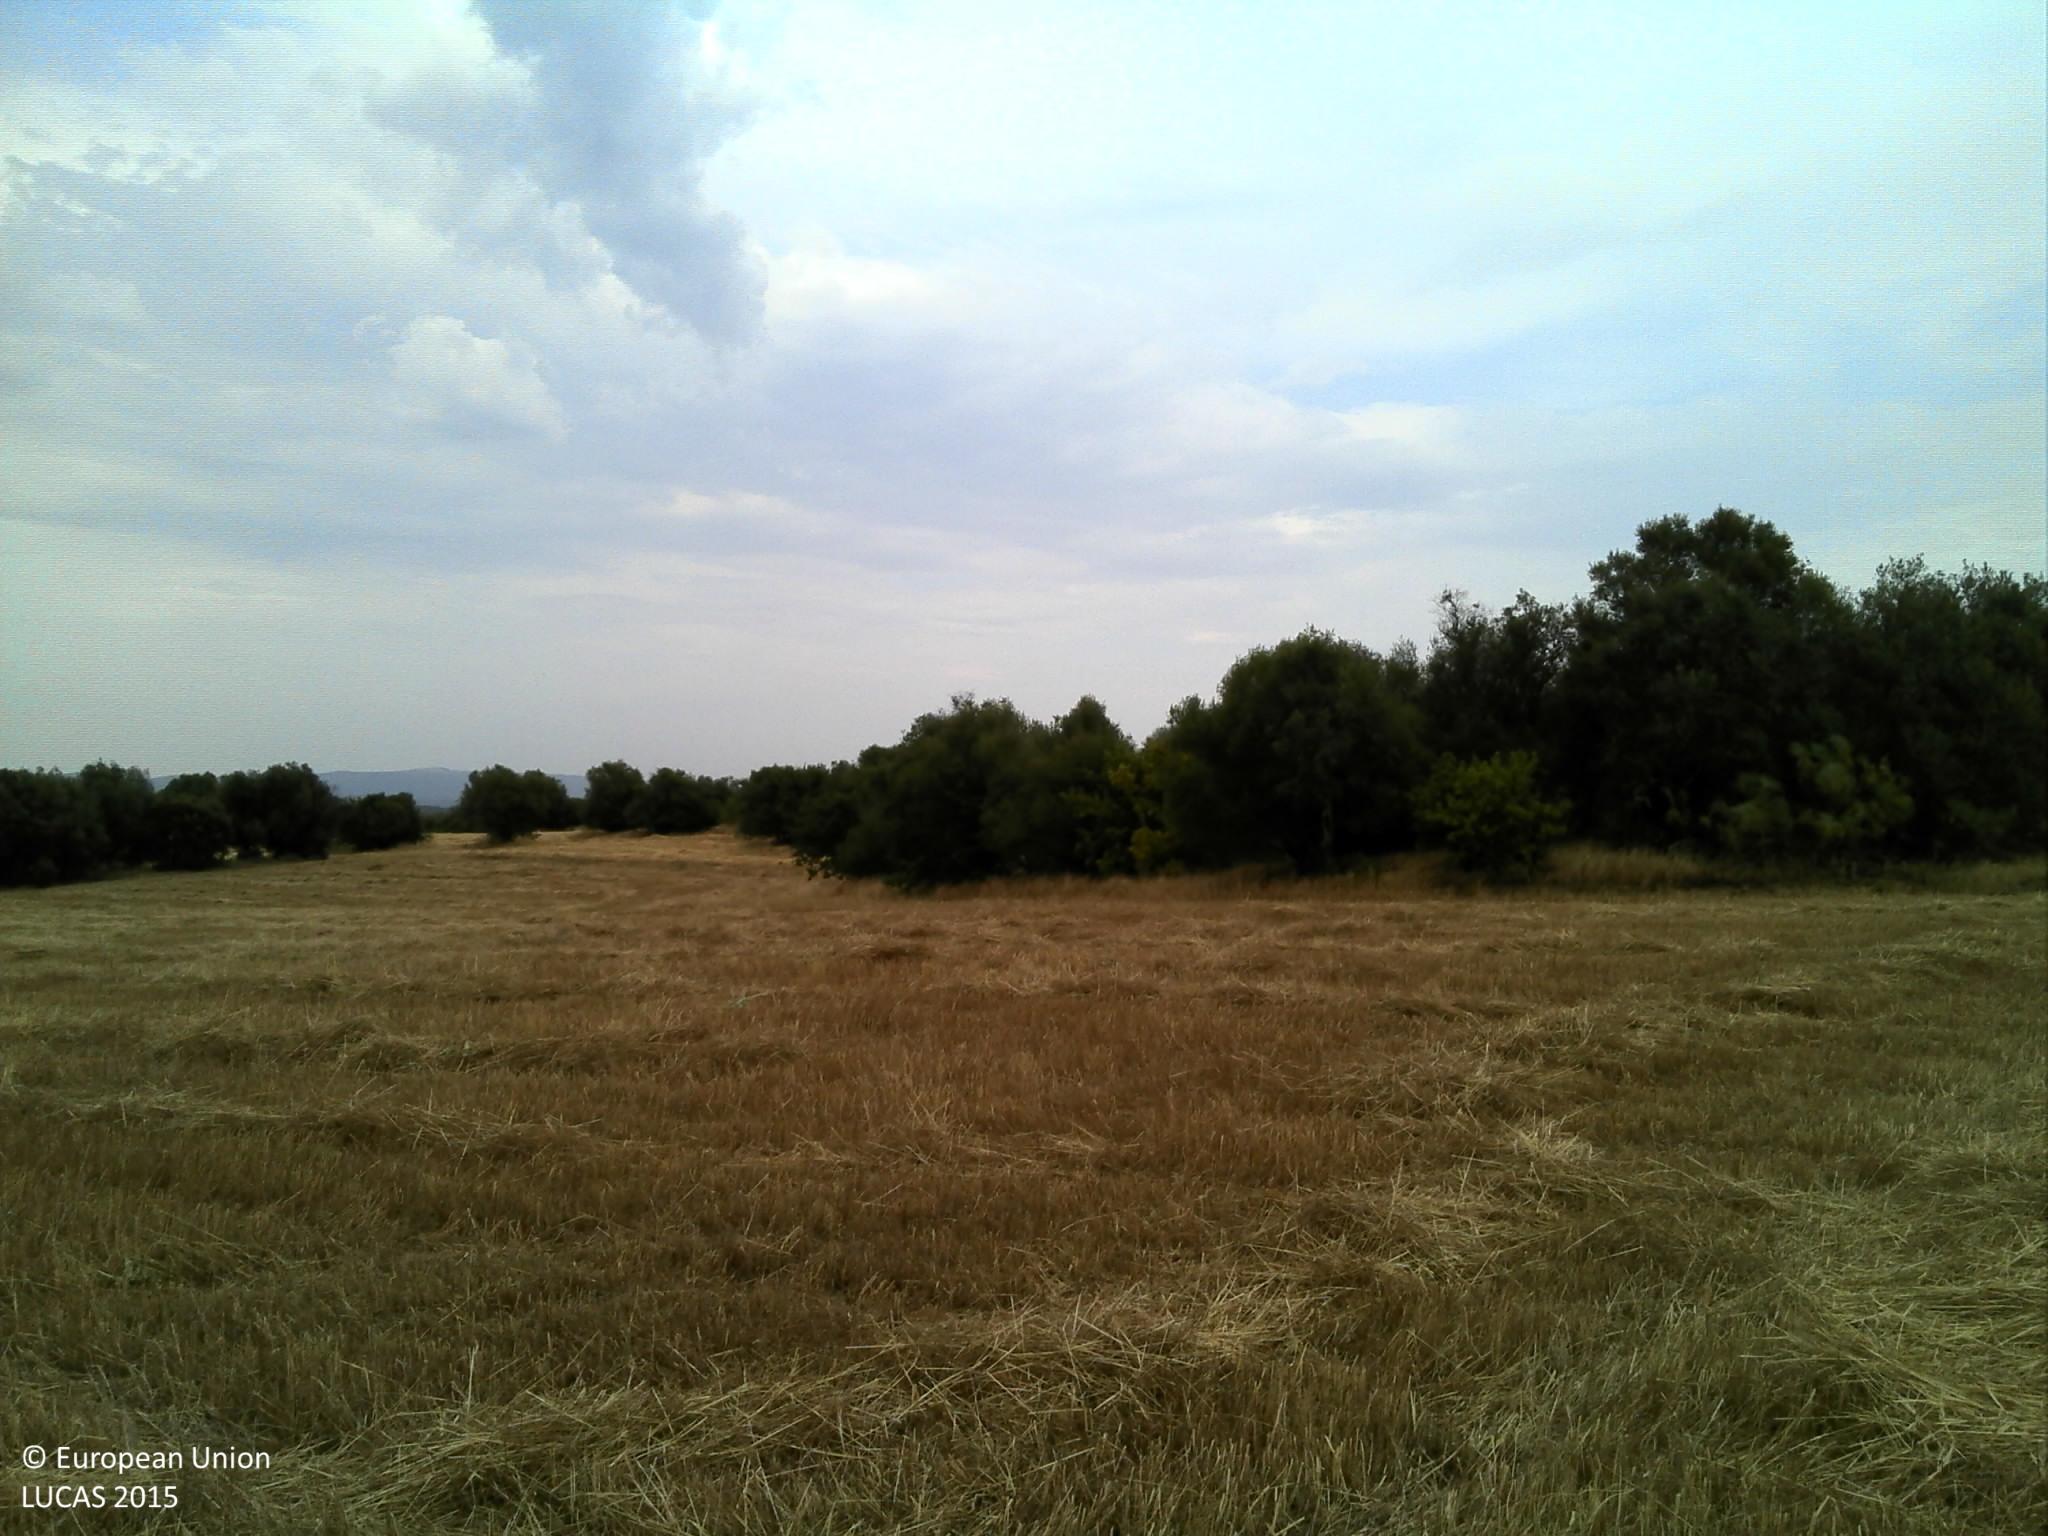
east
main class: Cropland
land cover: Olive groves
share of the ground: 10 - 25 %
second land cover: Mixed cereals for fodder
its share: < 10 %
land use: Agriculture (excluding fallow land and kitchen gardens)
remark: Harvested field
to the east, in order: Olive groves; Mixed cereals for fodder; Olive groves; Mixed cereals for fodder; Olive groves
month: June
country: PT
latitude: 38.6670
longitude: -7.7717
